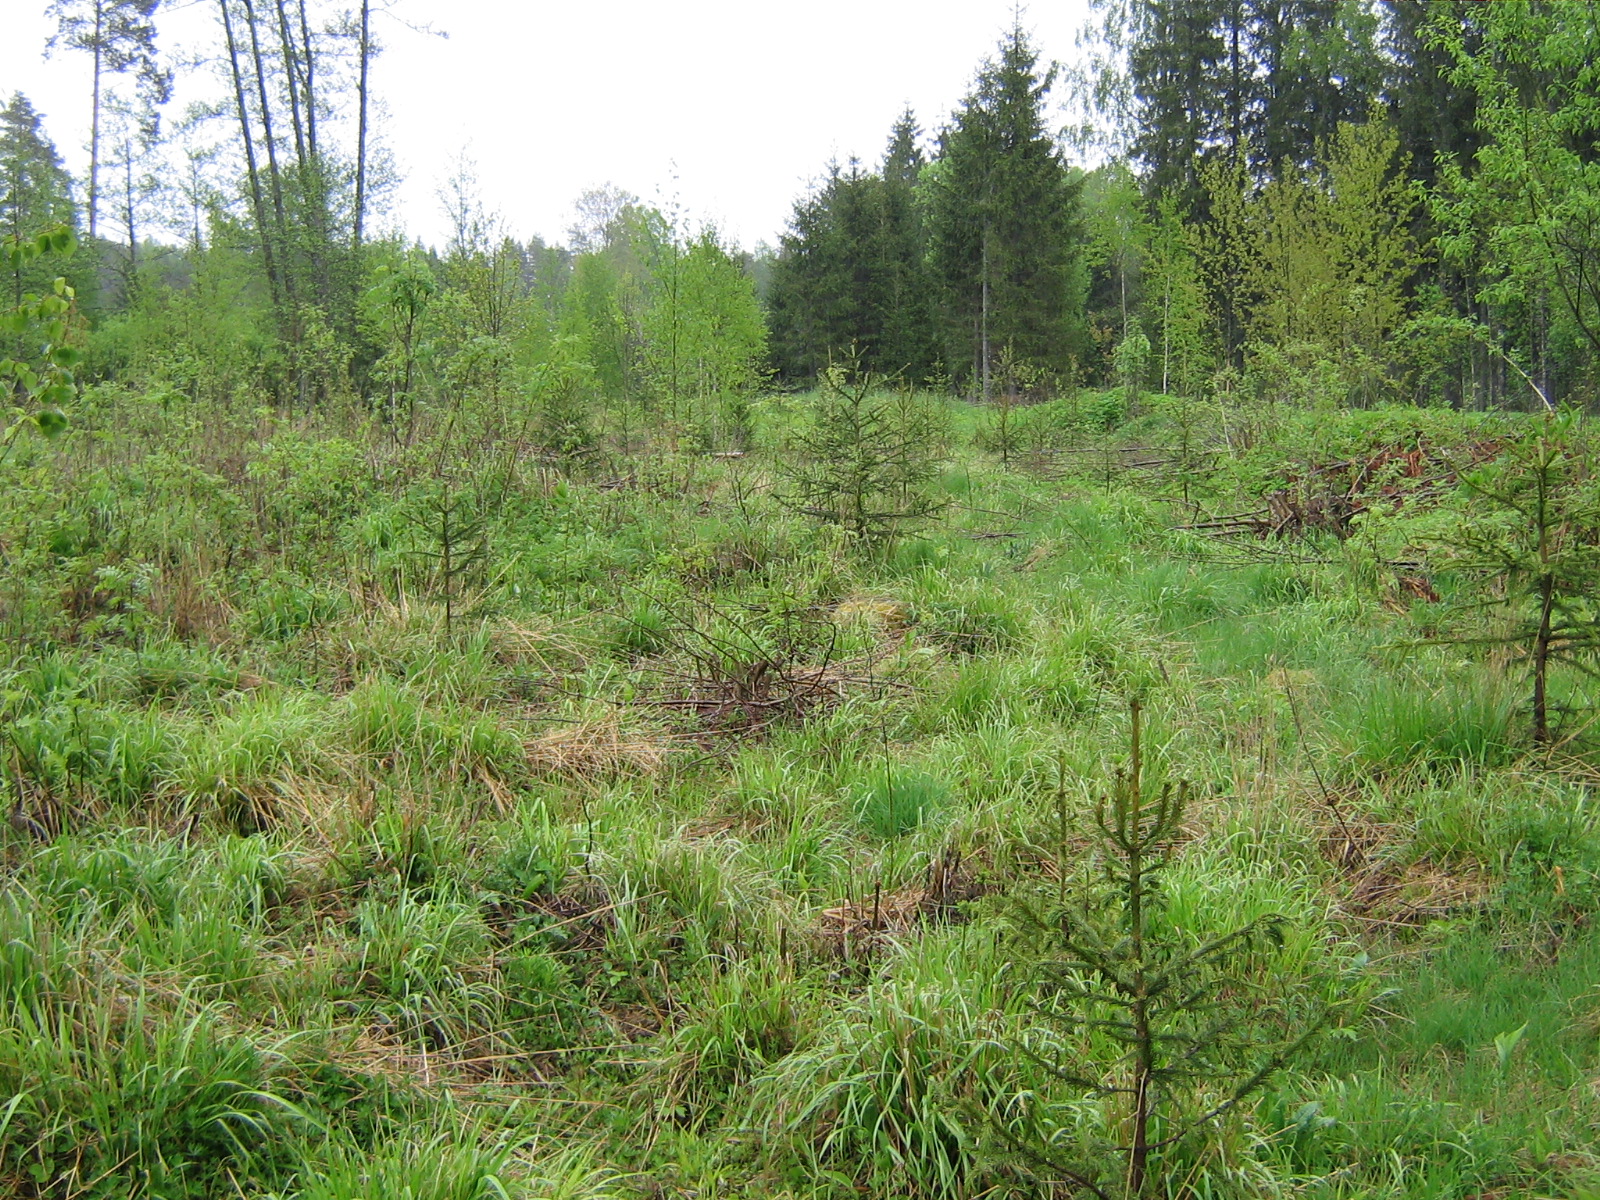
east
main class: Woodland
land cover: Spruce dominated mixed woodland
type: hemiboreal forest and nemoral coniferous forest and mixed broadleaved-coniferous forest
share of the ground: 25 - 50 %
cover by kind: herbaceous plants 60 %, coniferous forest trees 25 %, broadleaved forest trees 15 %
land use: Forestry
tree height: < 5 m
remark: Clear cut
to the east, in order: Spruce dominated mixed woodland; Spontaneously vegetated surfaces; Spruce dominated mixed woodland; Grass margins; Shruby margins; Paved roads, cycling and walking lanes; Grass margins; Spruce dominated mixed woodland; Grassland with sparse tree/shrub cover; Ditches and canals; Spruce dominated mixed woodland
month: May
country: LV
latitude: 57.3126
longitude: 25.9499
